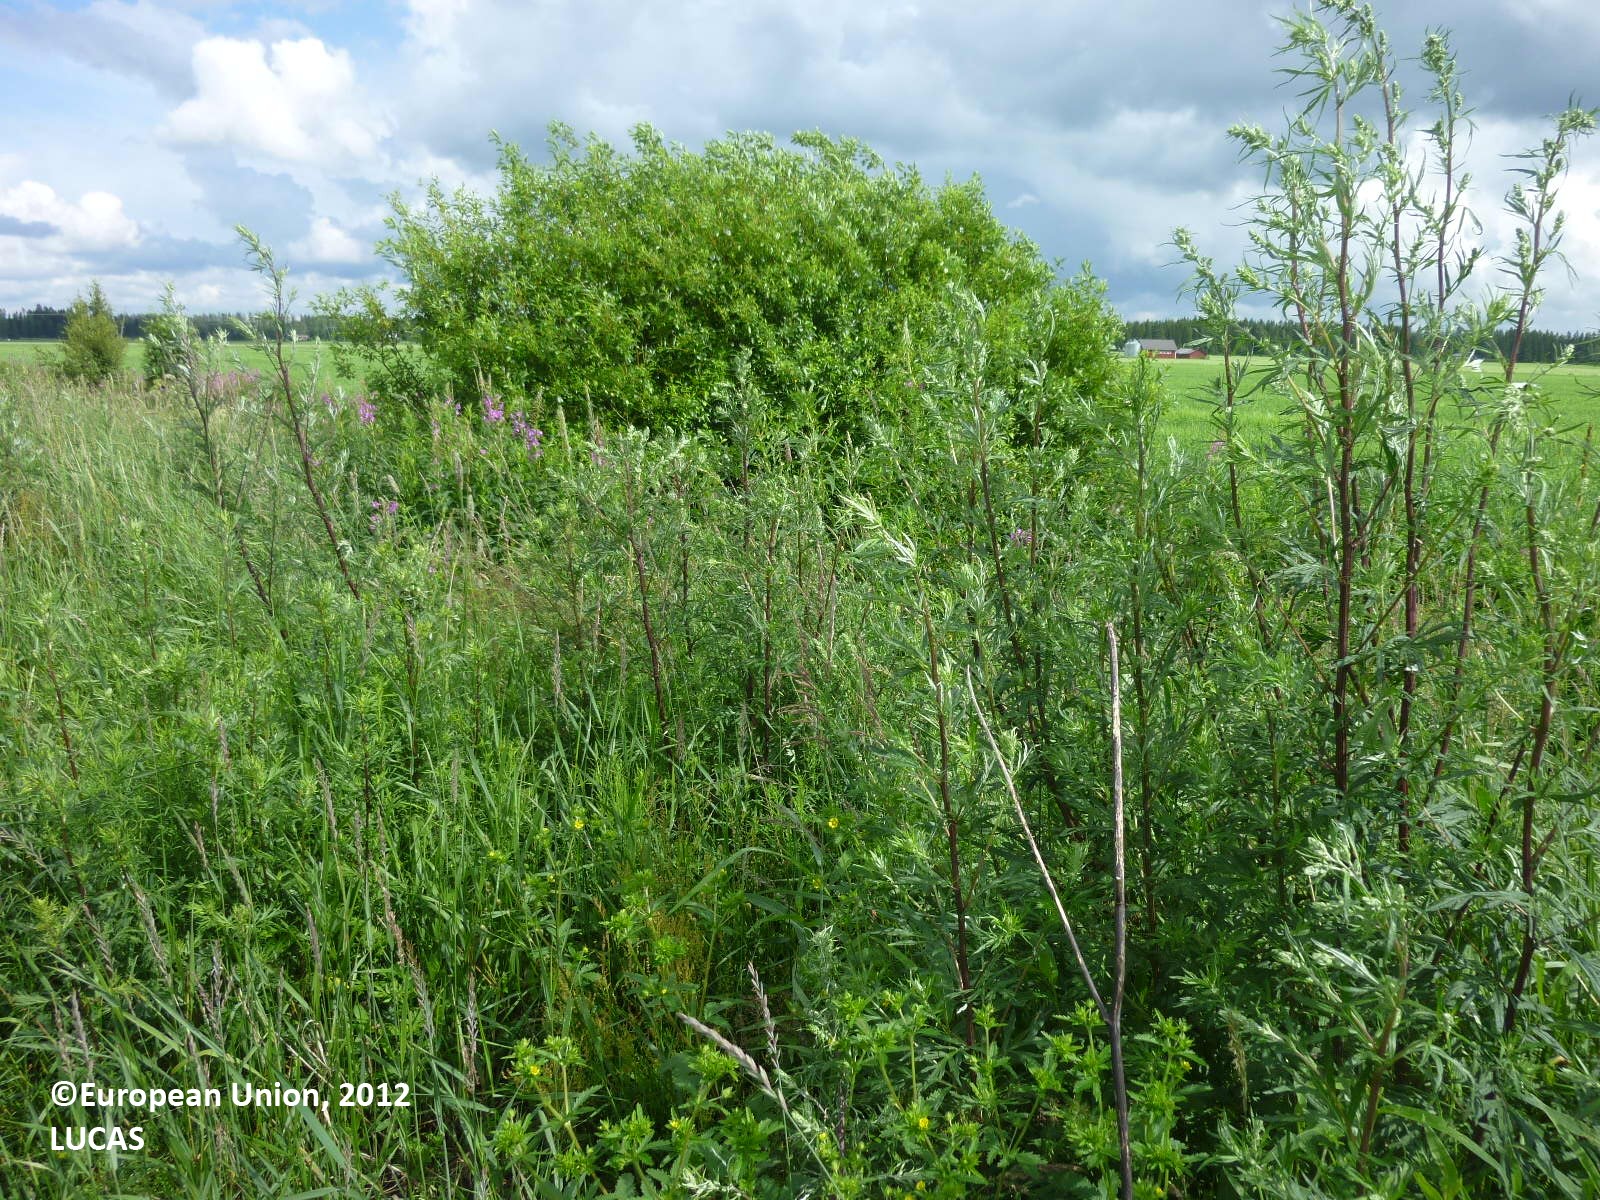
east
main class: Cropland
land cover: Barley
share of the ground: > 75 %
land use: Agriculture (excluding fallow land and kitchen gardens)
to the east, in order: Barley; Shruby margins; Abandoned hedges; Ditches and canals; Shruby margins; Barley
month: July
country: FI
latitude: 61.2239
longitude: 21.9196
